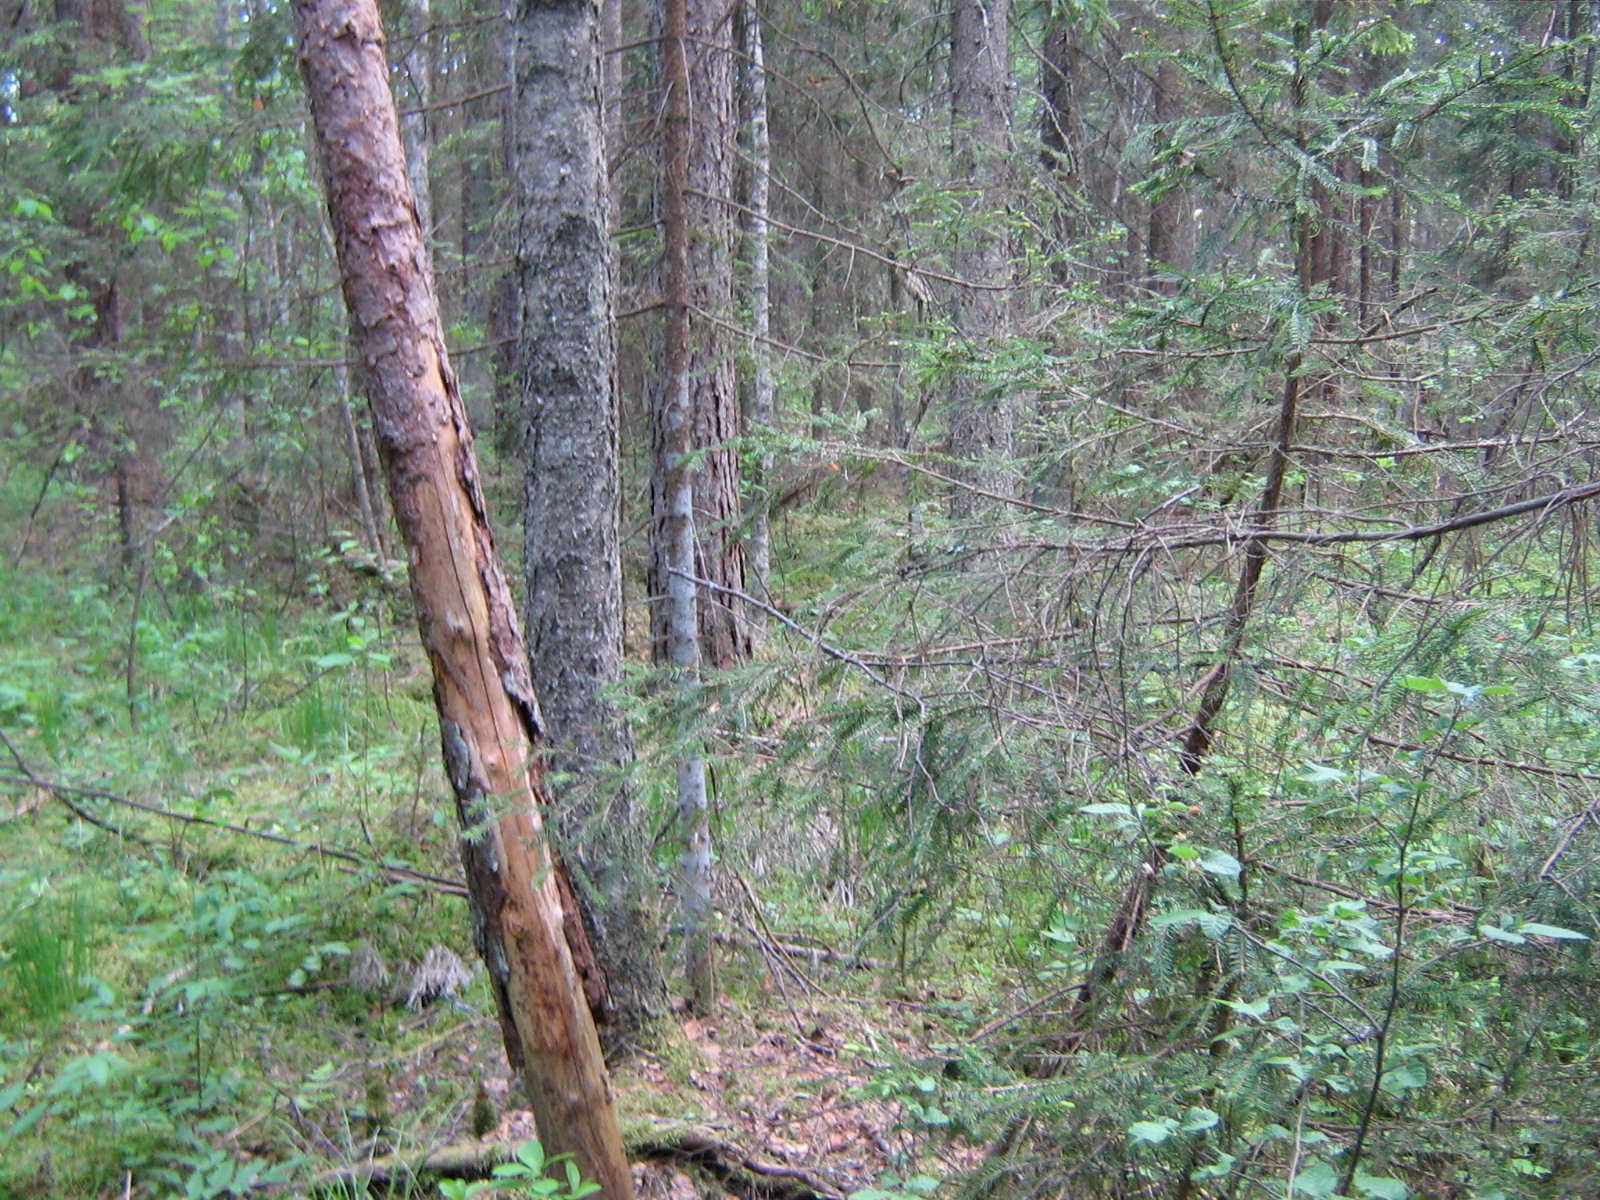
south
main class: Woodland
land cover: Spruce dominated mixed woodland
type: hemiboreal forest and nemoral coniferous forest and mixed broadleaved-coniferous forest
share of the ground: > 75 %
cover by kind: coniferous forest trees 70 %, broadleaved forest trees 30 %
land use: Forestry
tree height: > 5 m
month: June
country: LV
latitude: 57.1944
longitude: 25.8646
